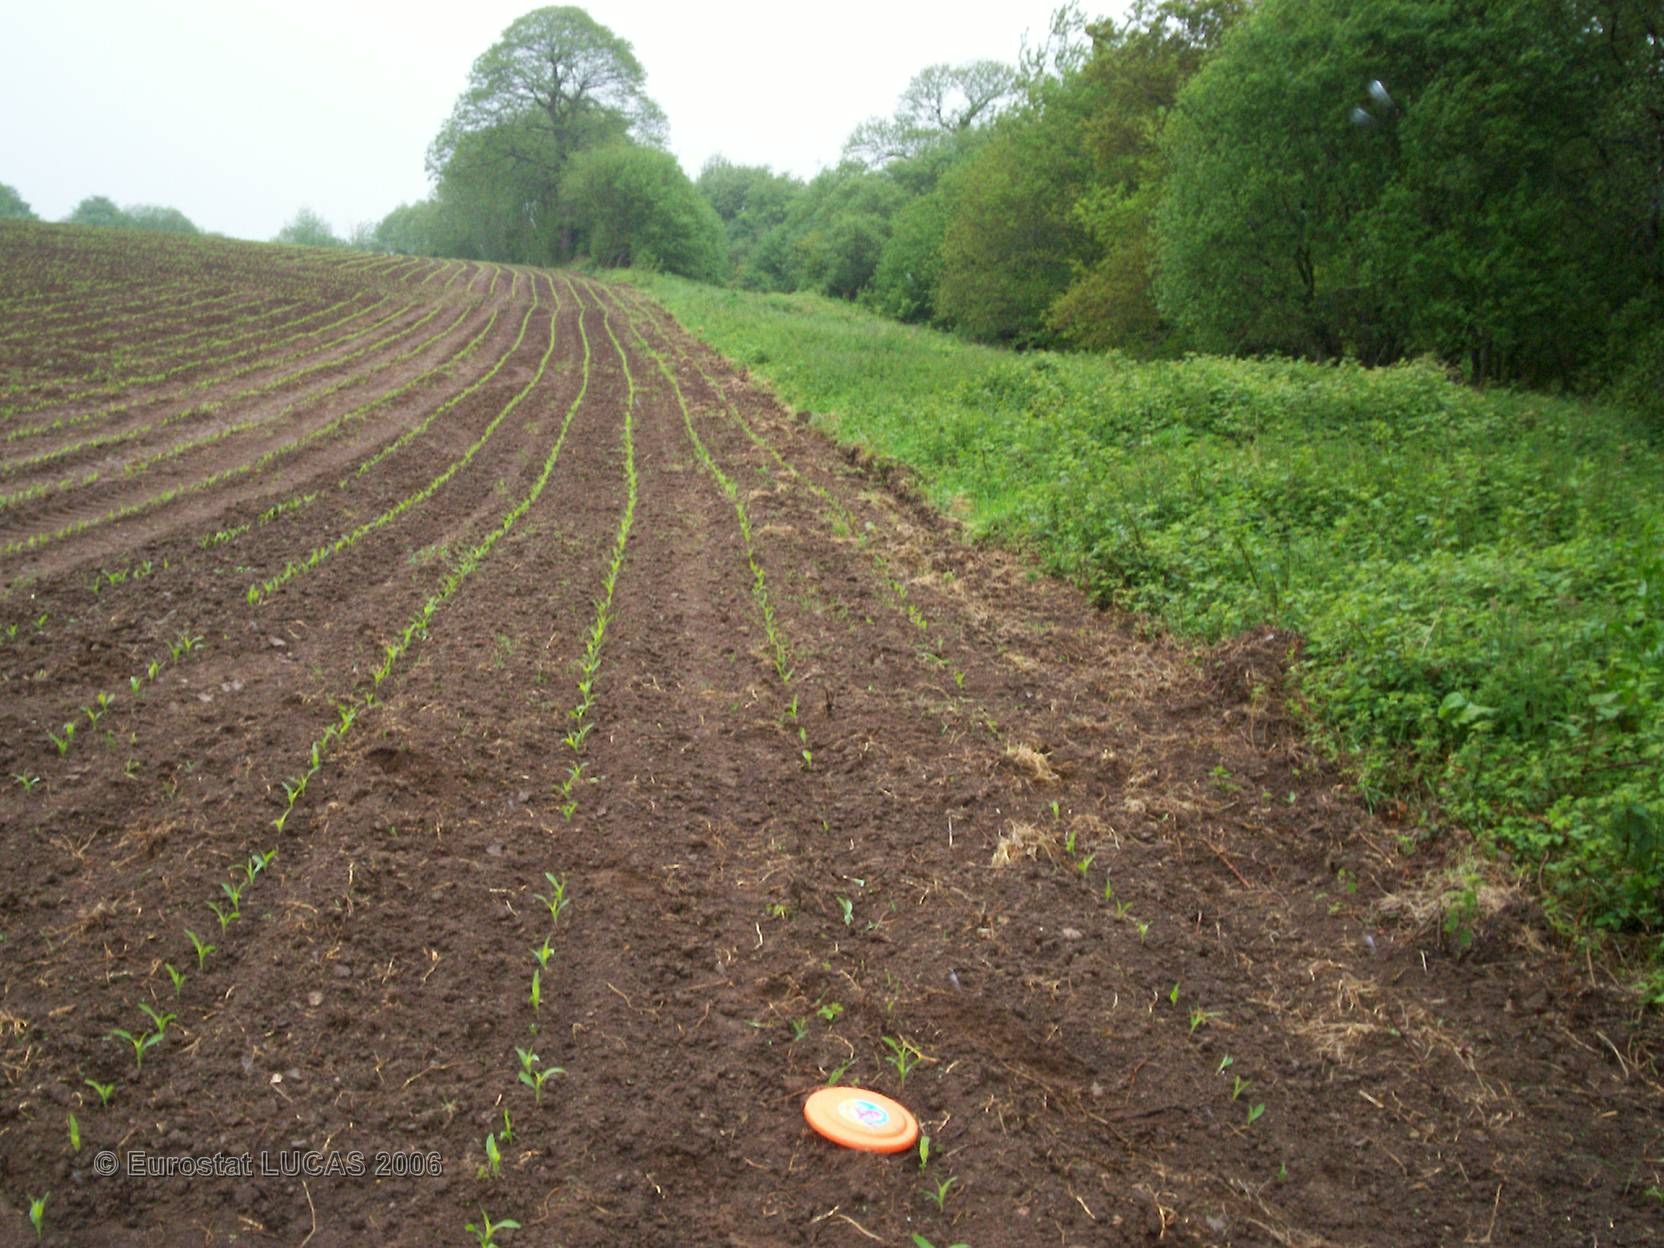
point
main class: Cropland
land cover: Maize
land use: Agriculture (excluding fallow land and kitchen gardens)
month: May
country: FR
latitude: 47.9099
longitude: -3.8501
